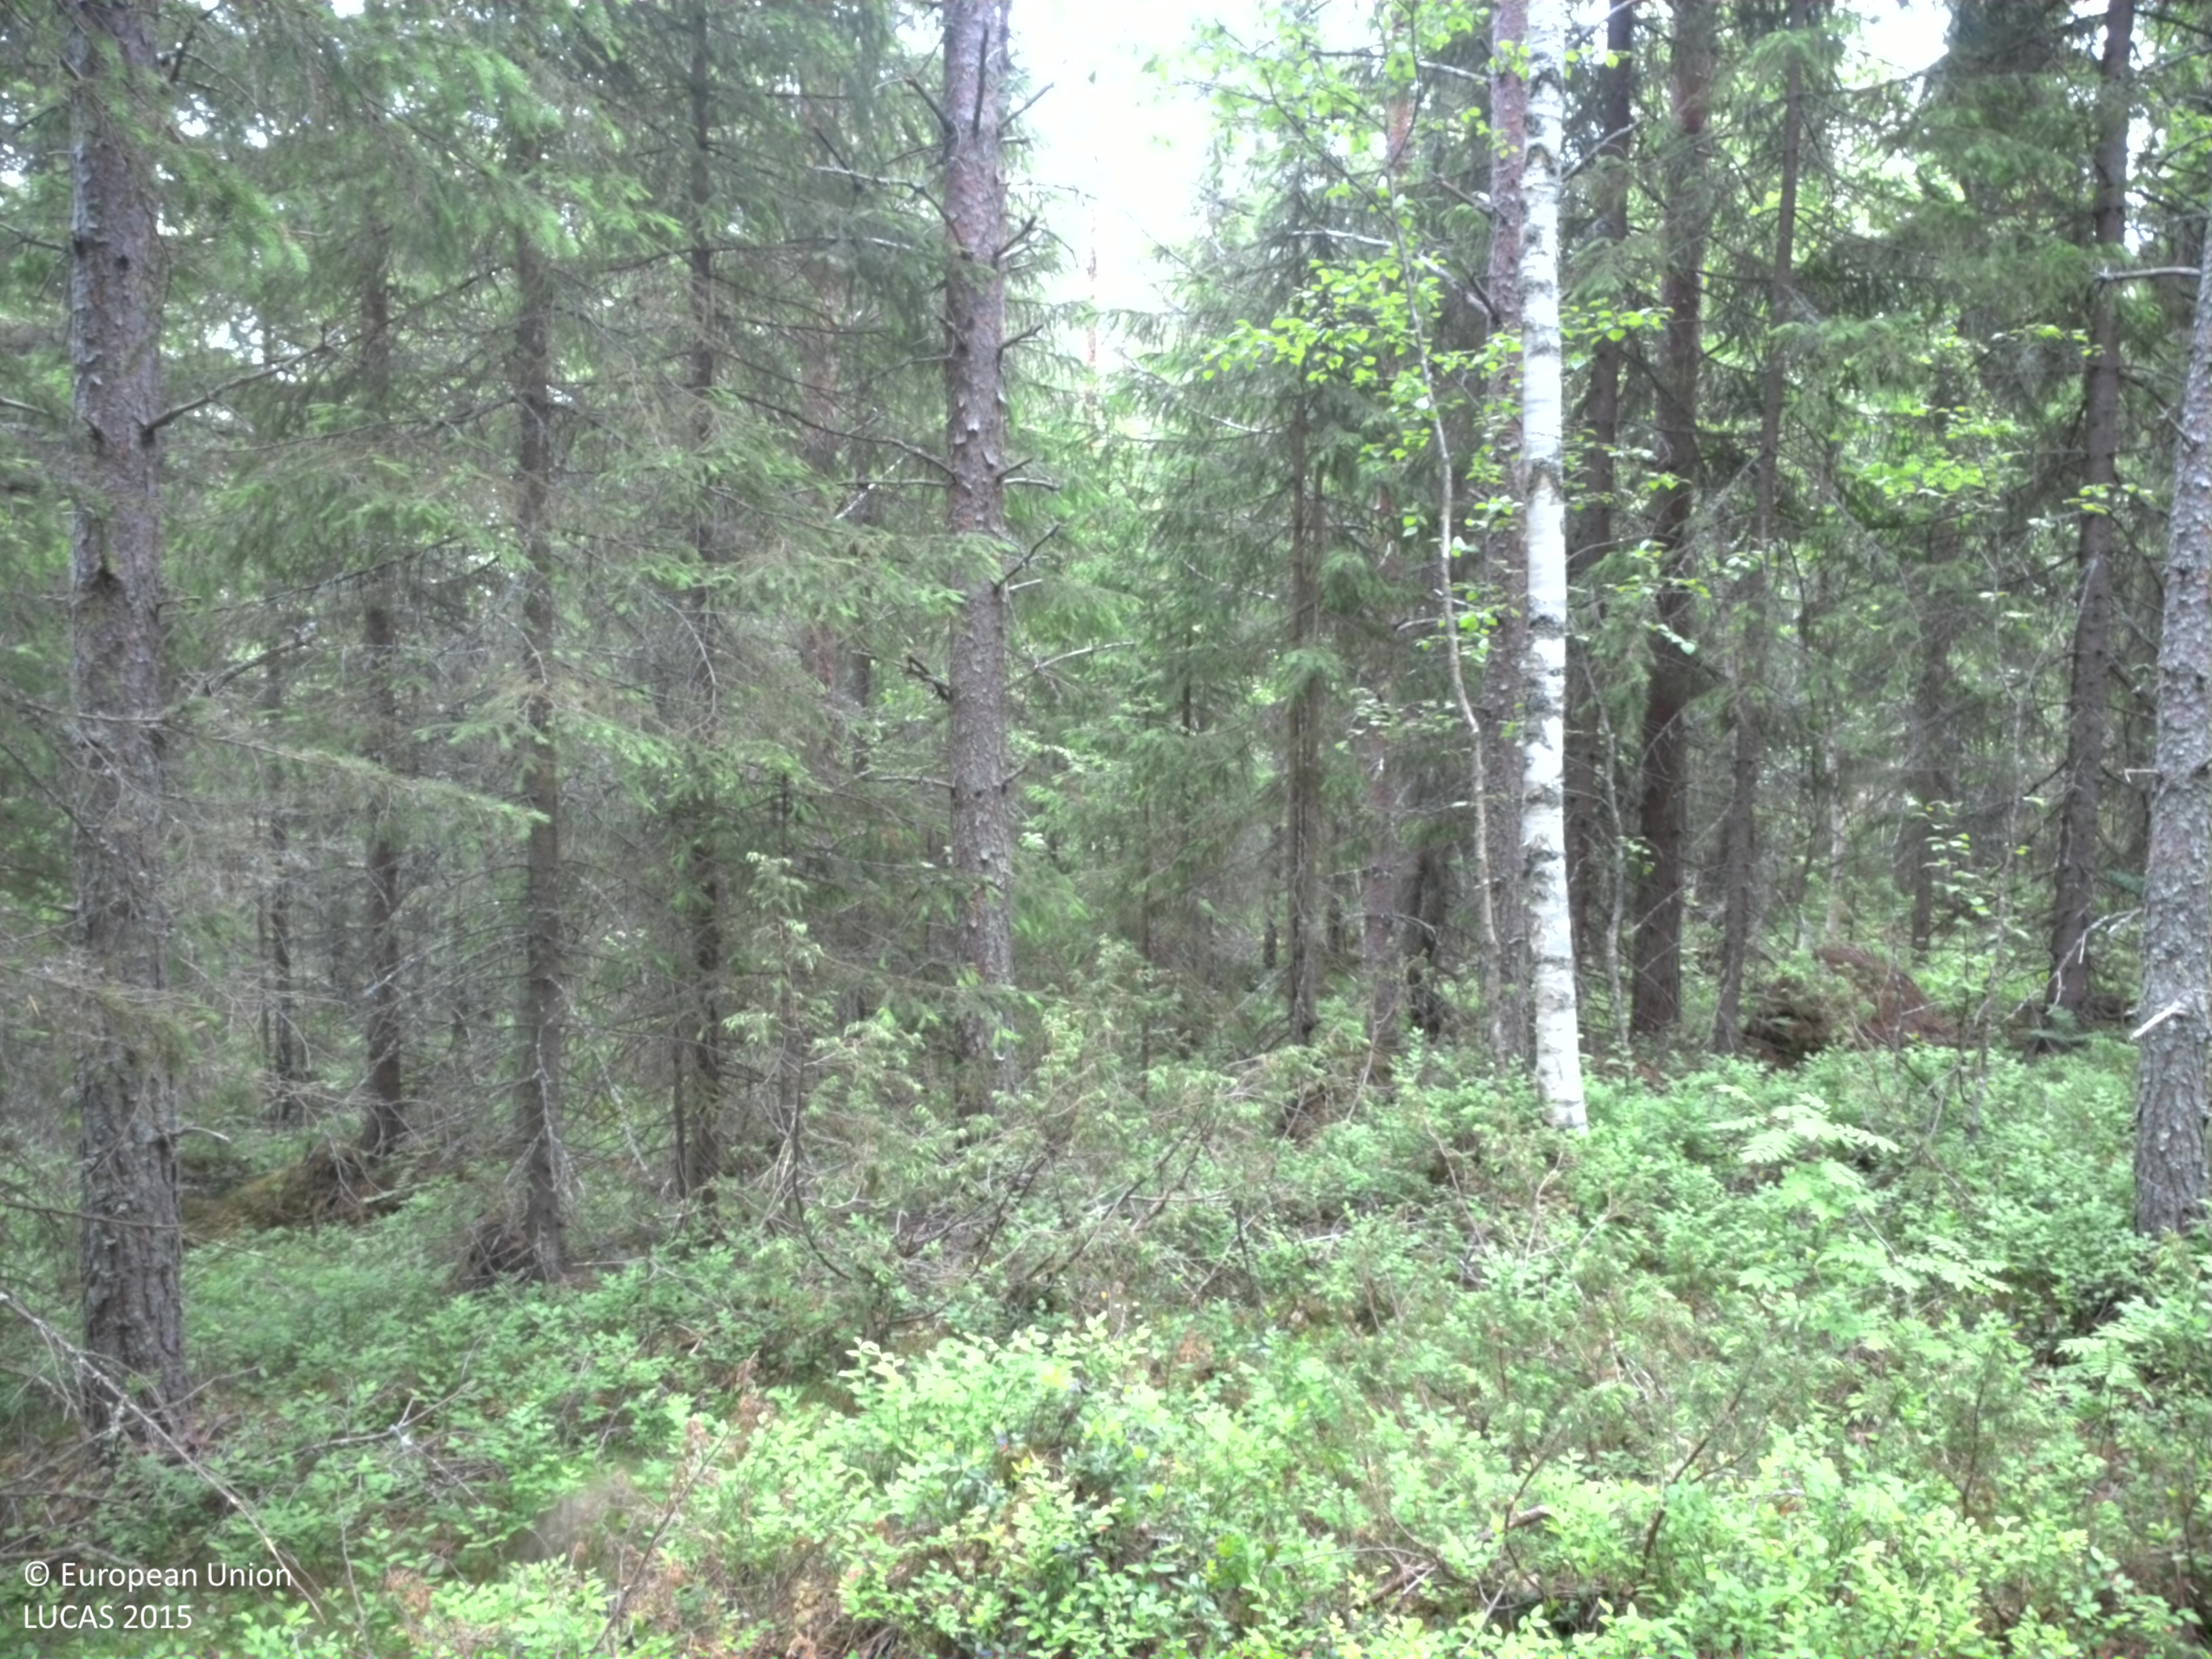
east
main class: Woodland
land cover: Other coniferous woodland
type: boreal forest
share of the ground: 50 - 75 %
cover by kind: coniferous forest trees 65 %, shrubs 25 %, broadleaved forest trees 10 %
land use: Forestry
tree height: > 5 m
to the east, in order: Other coniferous woodland; Other mixed woodland; Other coniferous woodland
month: July
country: SE
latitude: 64.4512
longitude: 20.7651
